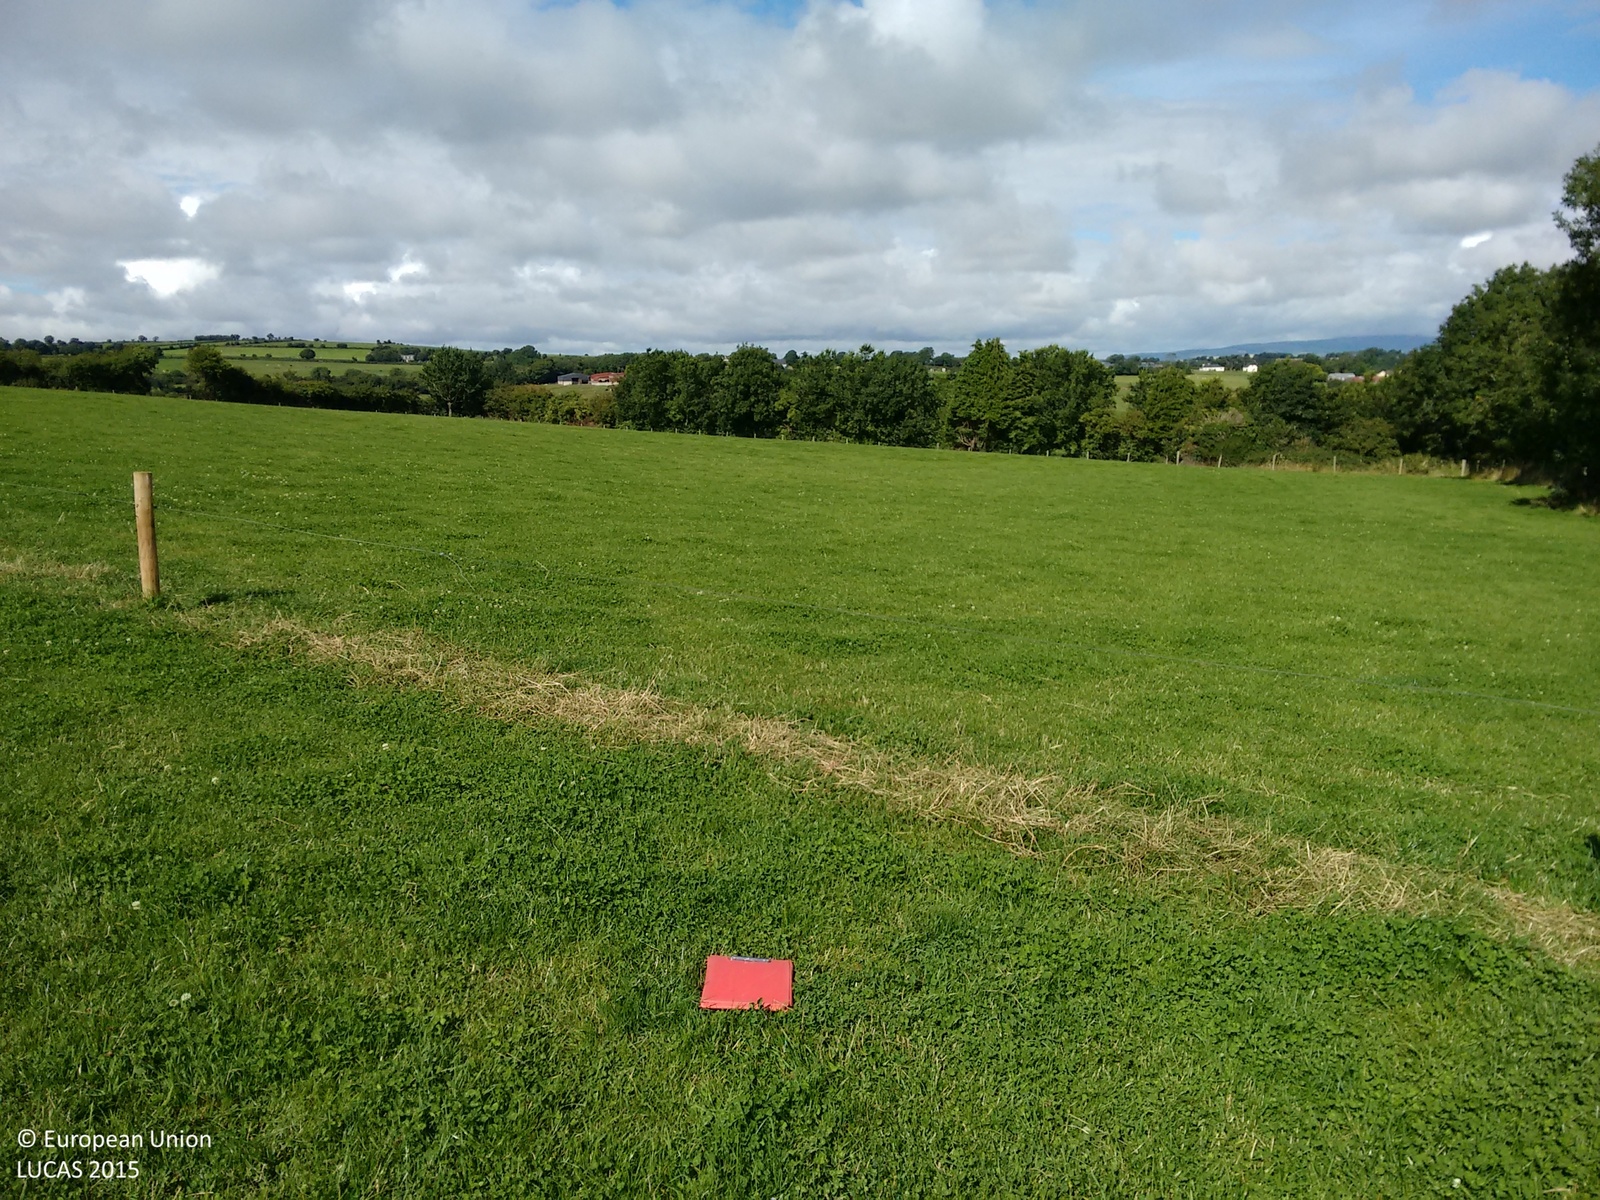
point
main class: Grassland
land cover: Grassland without tree/shrub cover
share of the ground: > 75 %
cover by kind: herbaceous plants 100 %
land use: Agriculture (excluding fallow land and kitchen gardens)
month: August
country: IE
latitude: 52.3868
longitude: -6.6320
